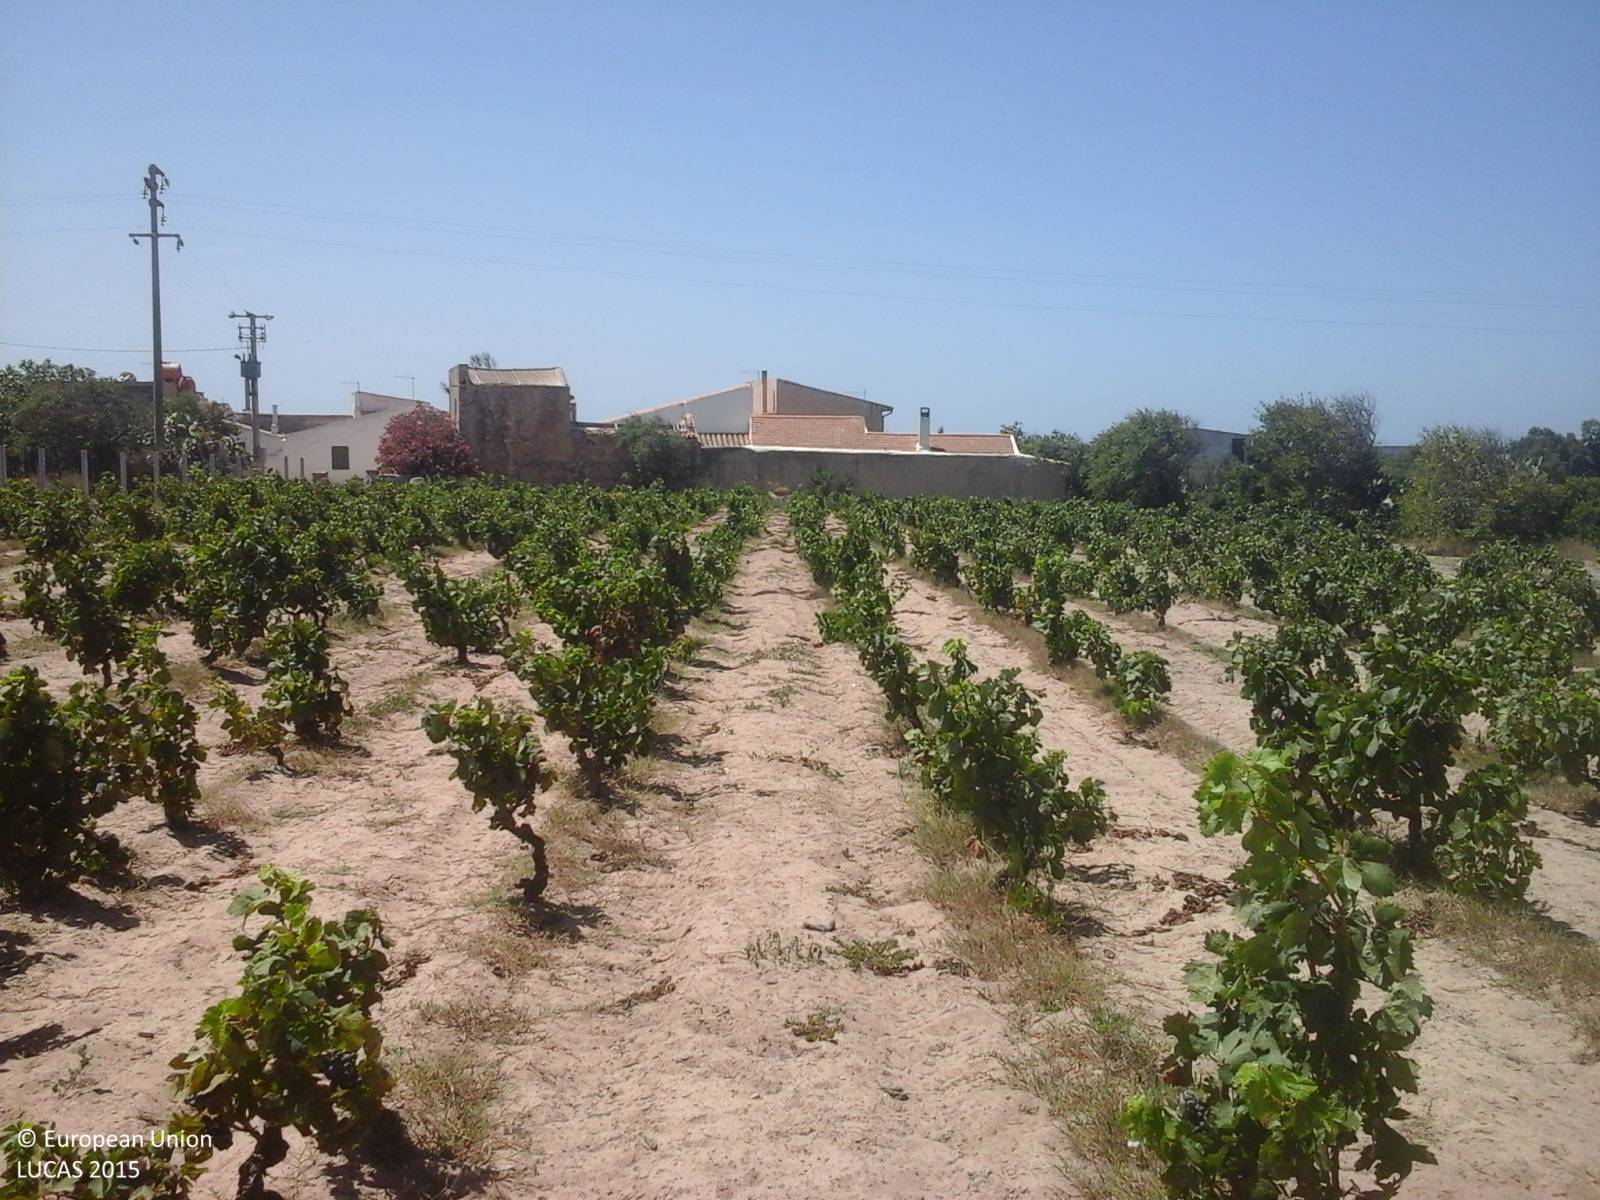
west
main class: Cropland
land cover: Vineyards
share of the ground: 50 - 75 %
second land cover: Other bare soil
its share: > 75 %
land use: Agriculture (excluding fallow land and kitchen gardens)
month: July
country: IT
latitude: 39.0949
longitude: 8.4029
